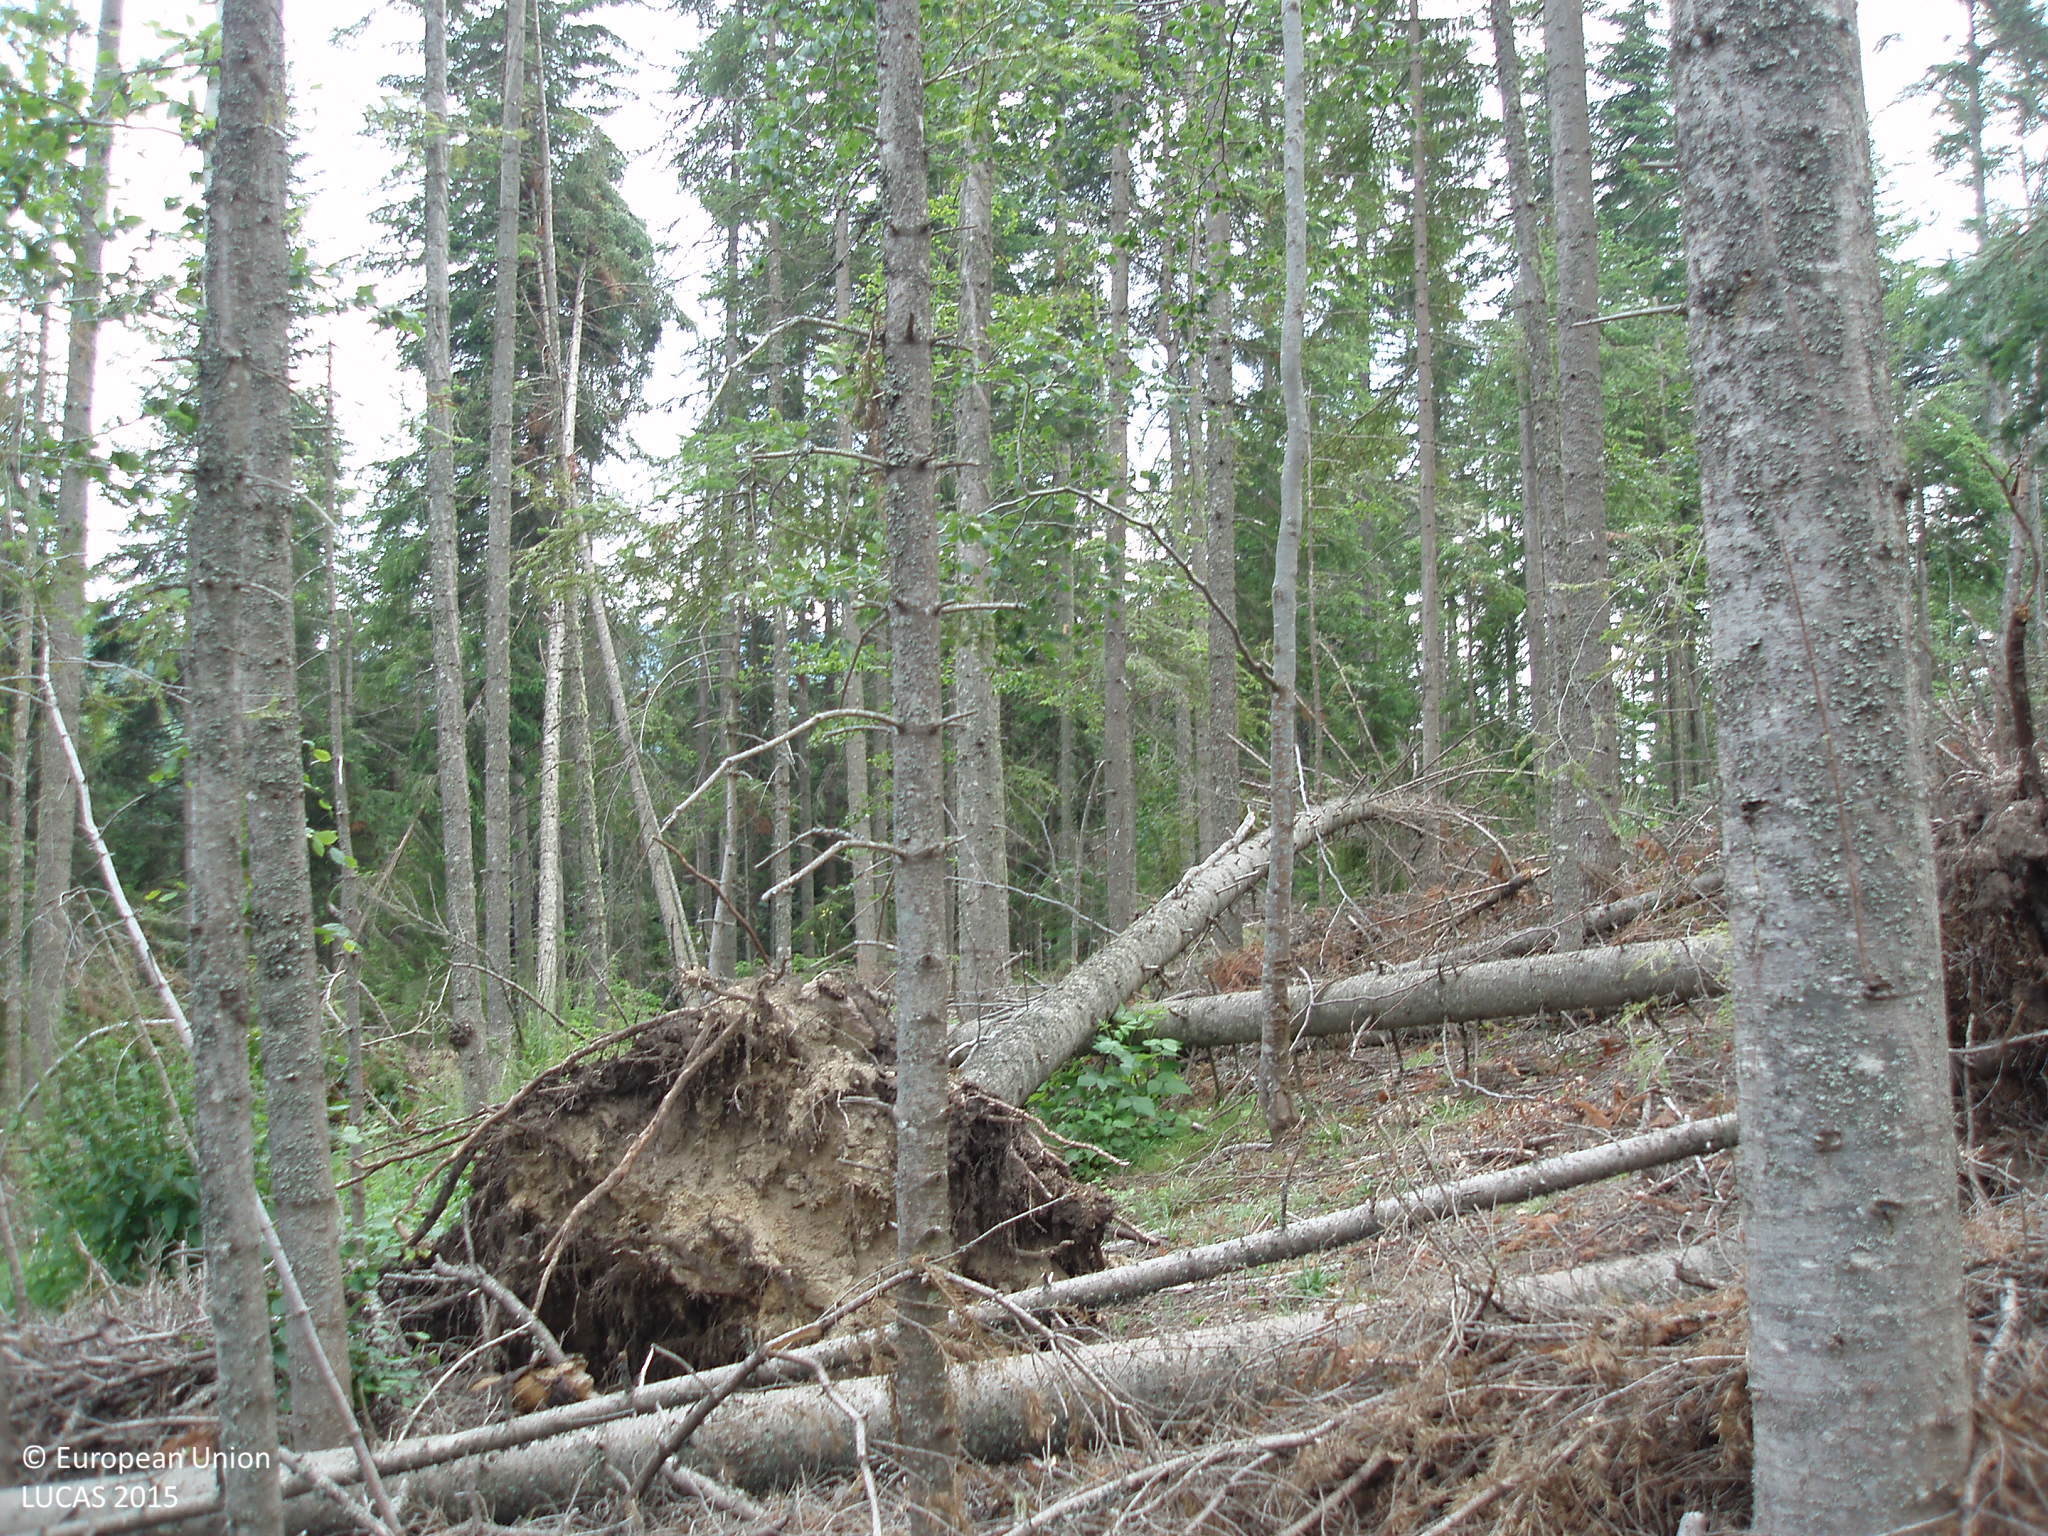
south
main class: Woodland
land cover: Spruce dominated coniferous woodland
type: hemiboreal forest and nemoral coniferous forest and mixed broadleaved-coniferous forest
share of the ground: > 75 %
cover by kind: coniferous forest trees 100 %
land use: Forestry
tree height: > 5 m
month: July
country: BG
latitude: 42.0779
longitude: 23.8763
